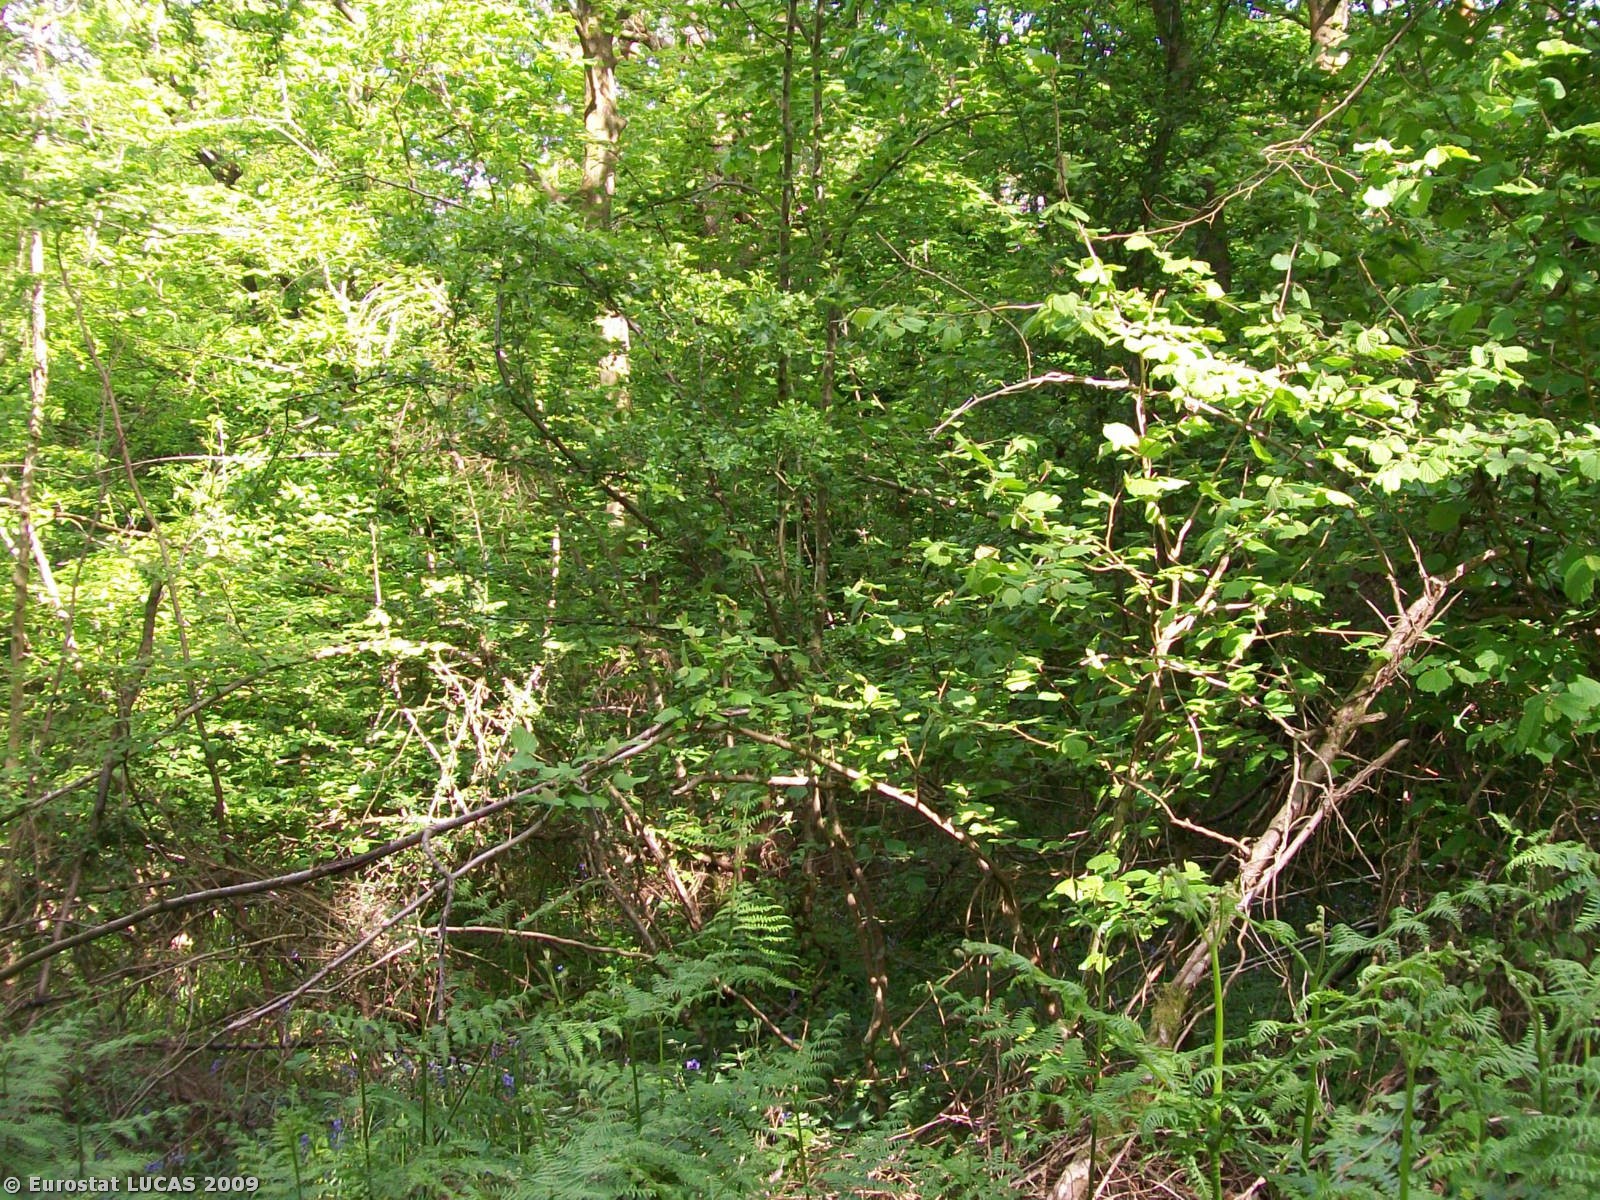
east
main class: Woodland
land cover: Mixed woodland
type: mesophytic deciduous forest
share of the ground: > 75 %
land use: Amenities, museums, leisure
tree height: > 5 m
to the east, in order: Mixed woodland; Broadleaved woodland; Coniferous woodland; Broadleaved woodland
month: May
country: GB
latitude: 50.9330
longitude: -2.1410
